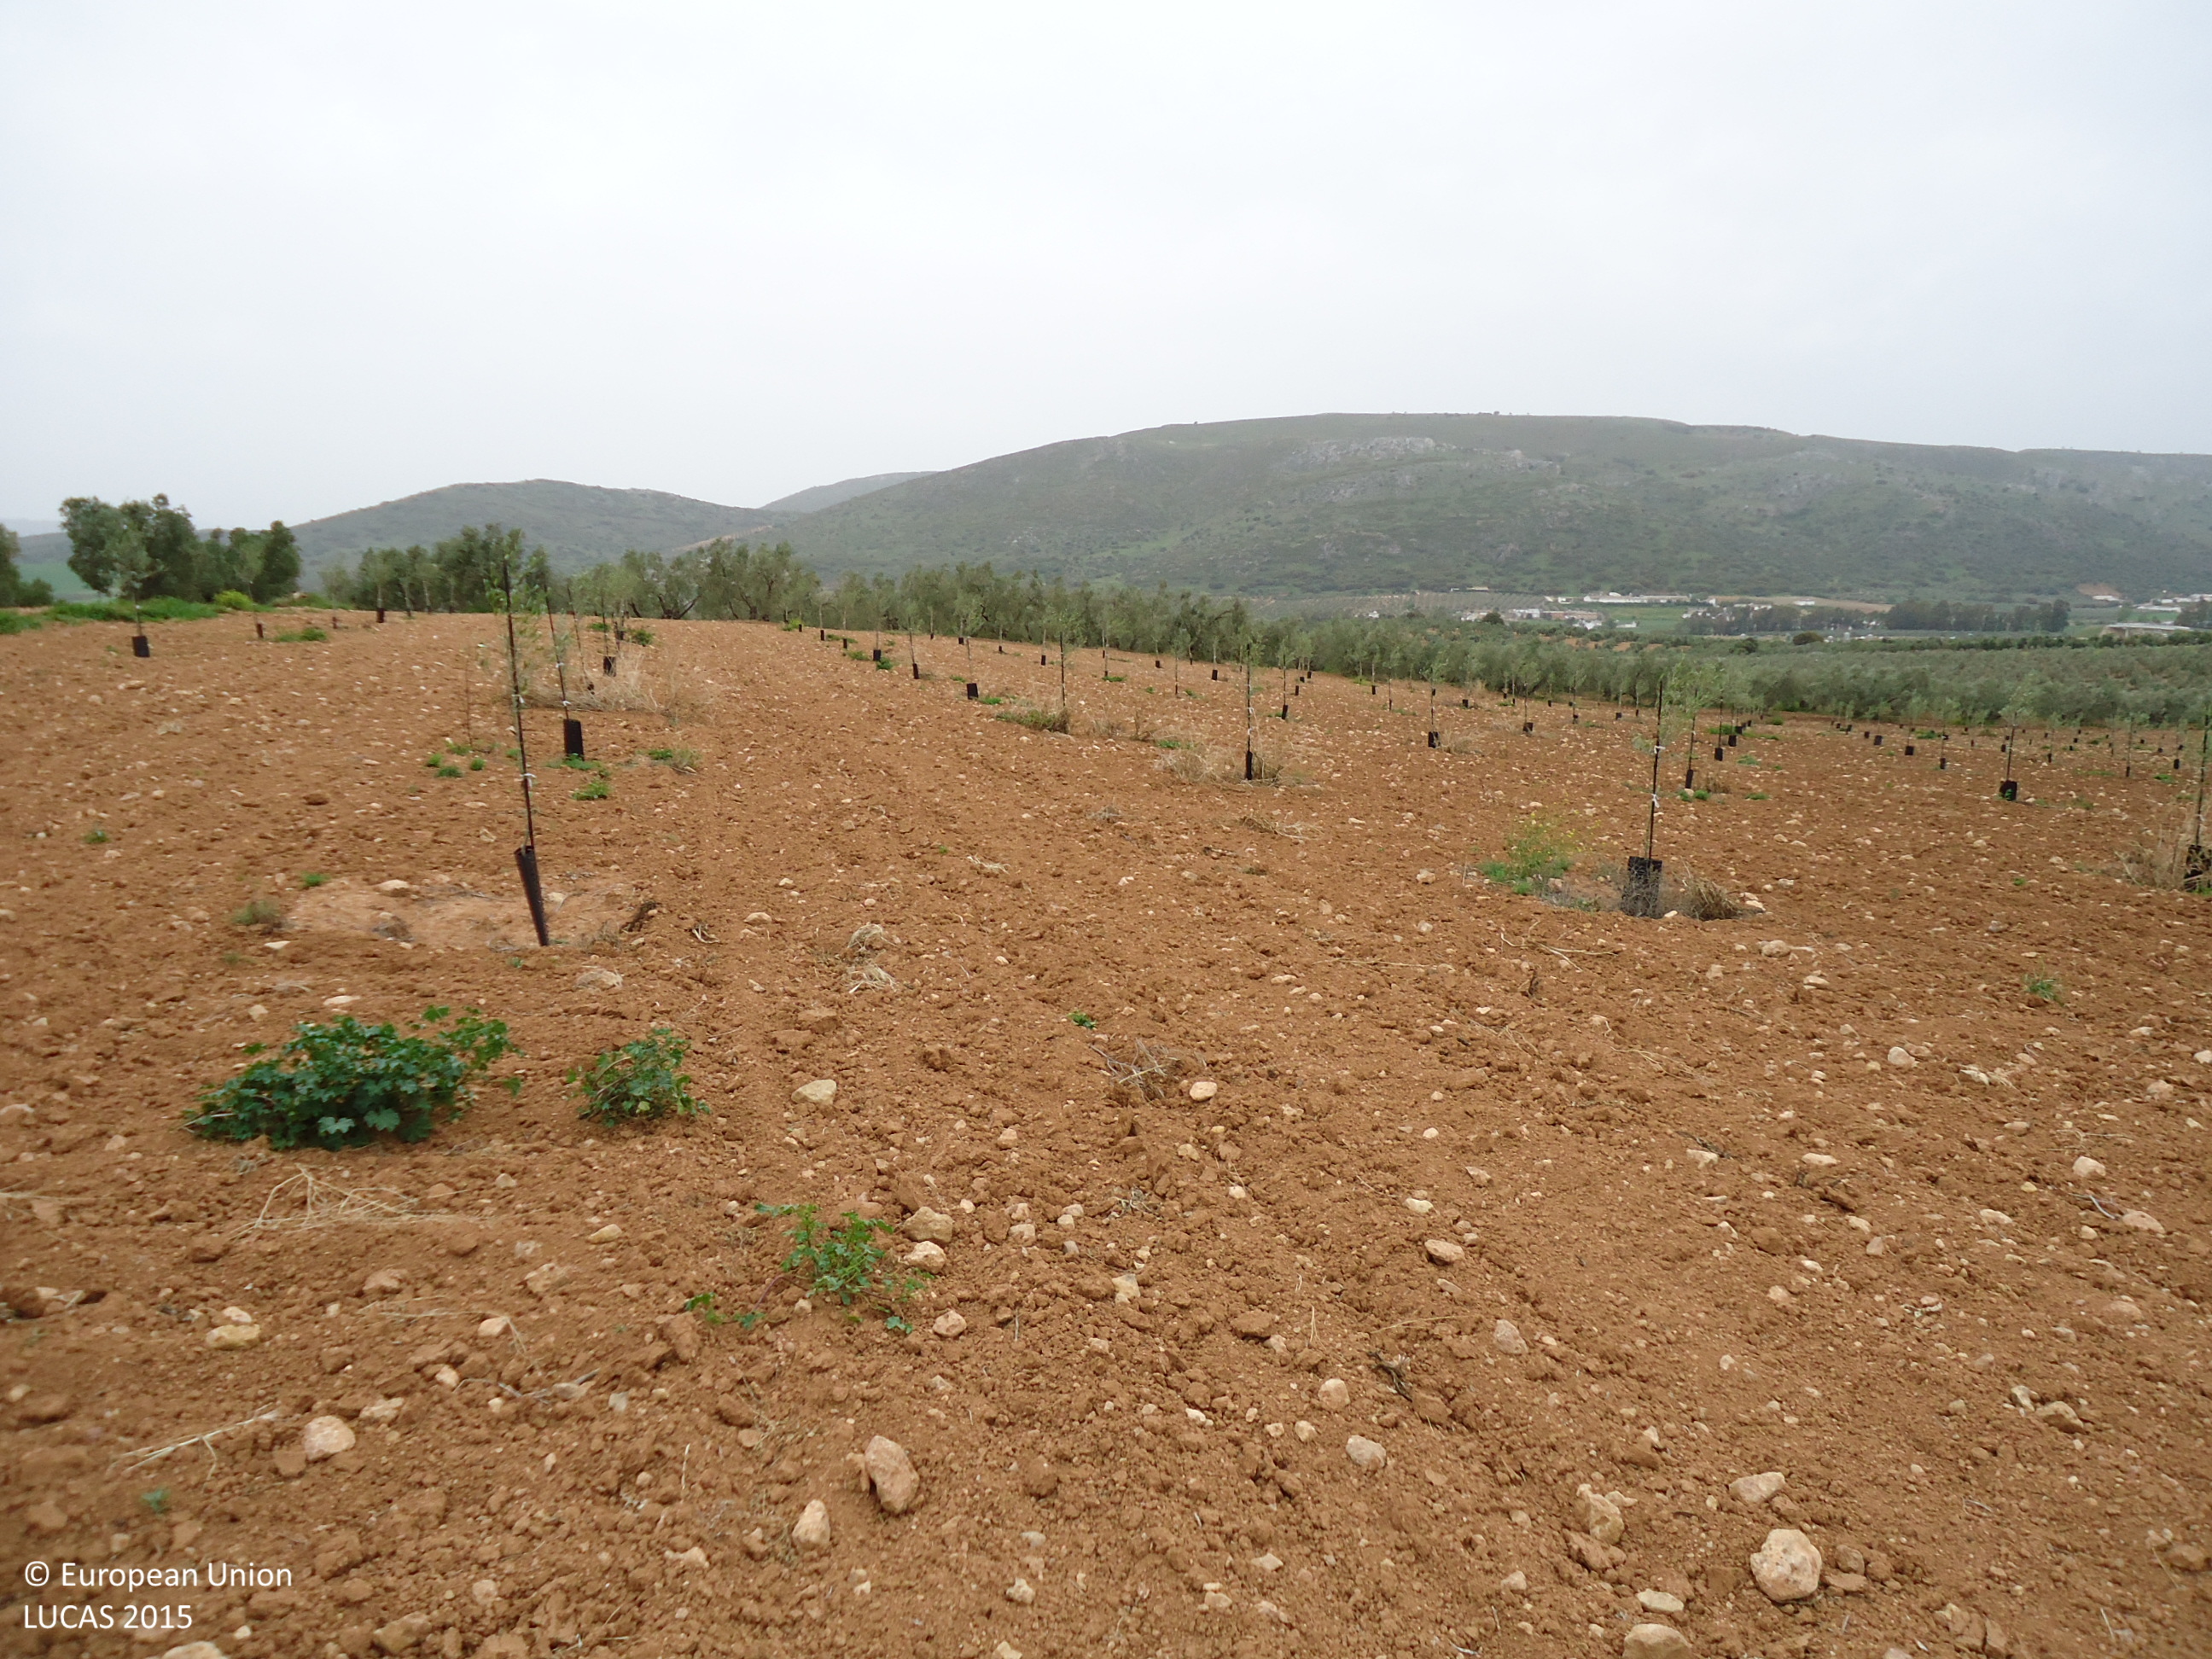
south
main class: Cropland
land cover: Olive groves
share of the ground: < 10 %
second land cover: Other bare soil
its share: > 75 %
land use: Agriculture (excluding fallow land and kitchen gardens)
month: April
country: ES
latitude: 37.0098
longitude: -5.0054
